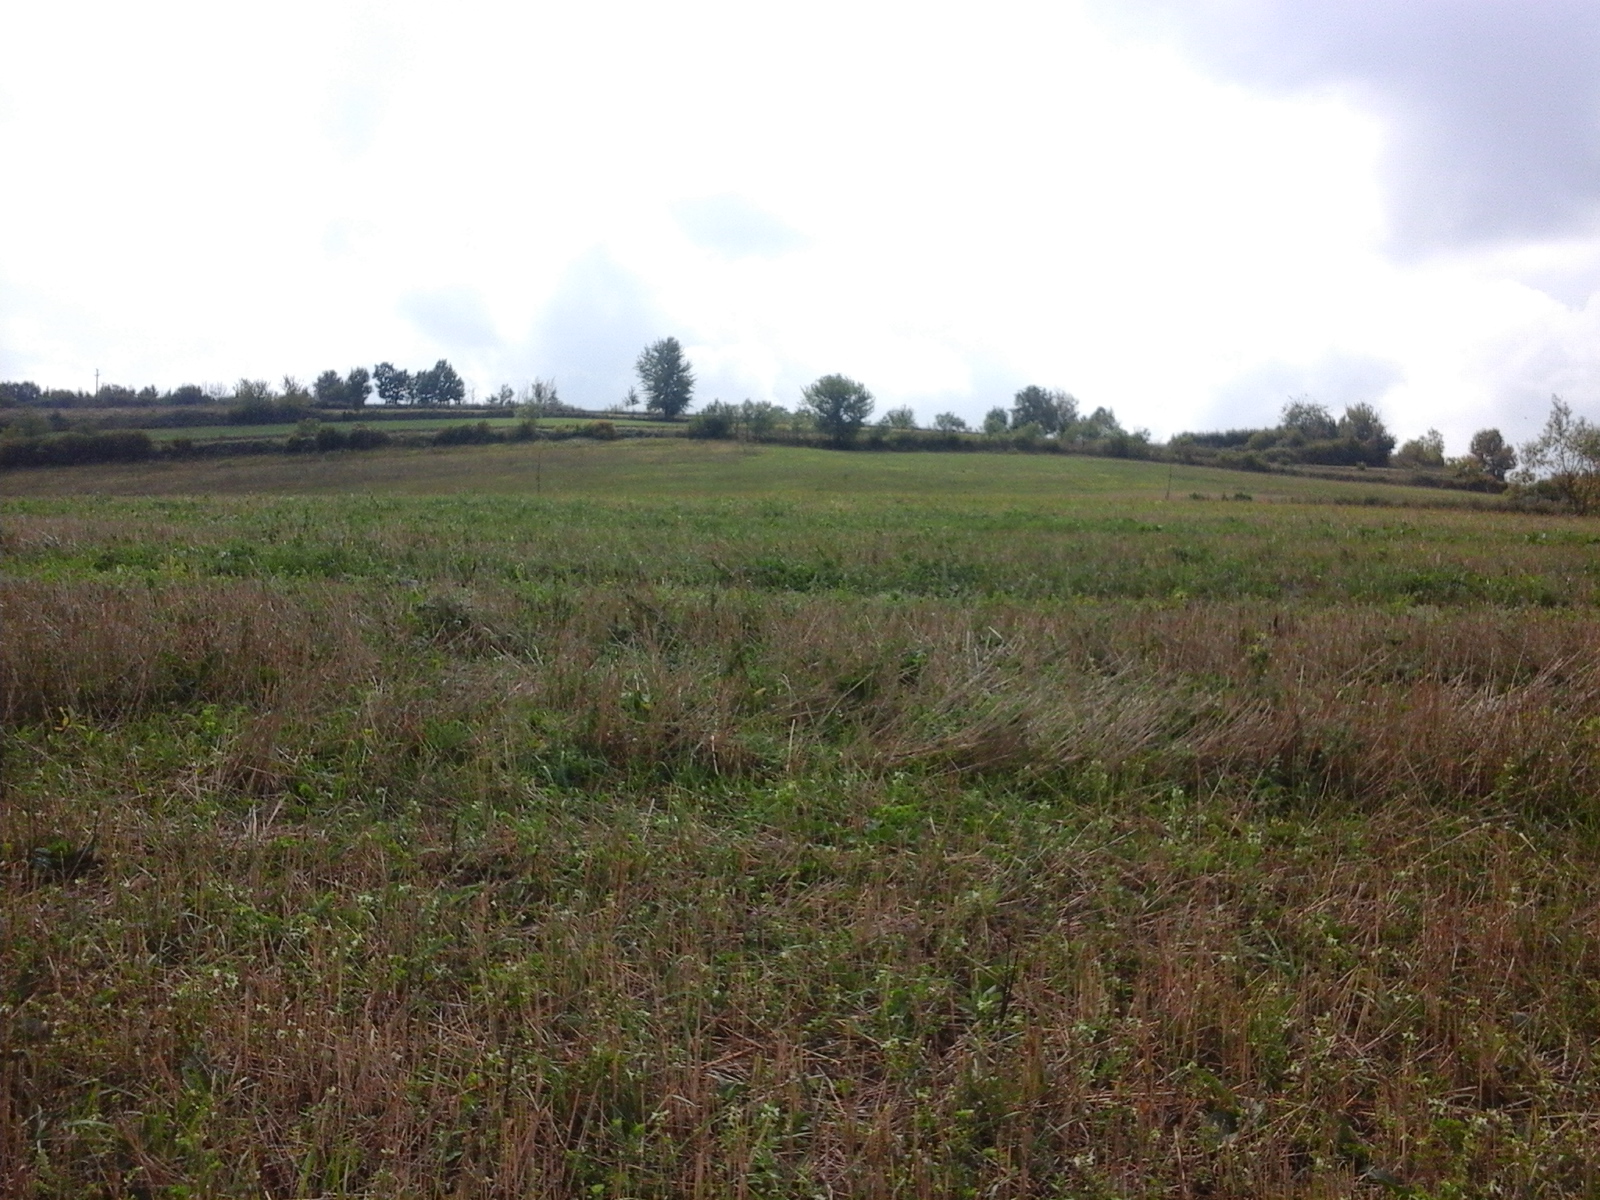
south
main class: Grassland
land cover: Grassland without tree/shrub cover
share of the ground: > 75 %
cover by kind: herbaceous plants 100 %
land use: Agriculture (excluding fallow land and kitchen gardens)
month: September
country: RO
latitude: 46.7029
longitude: 22.2251
